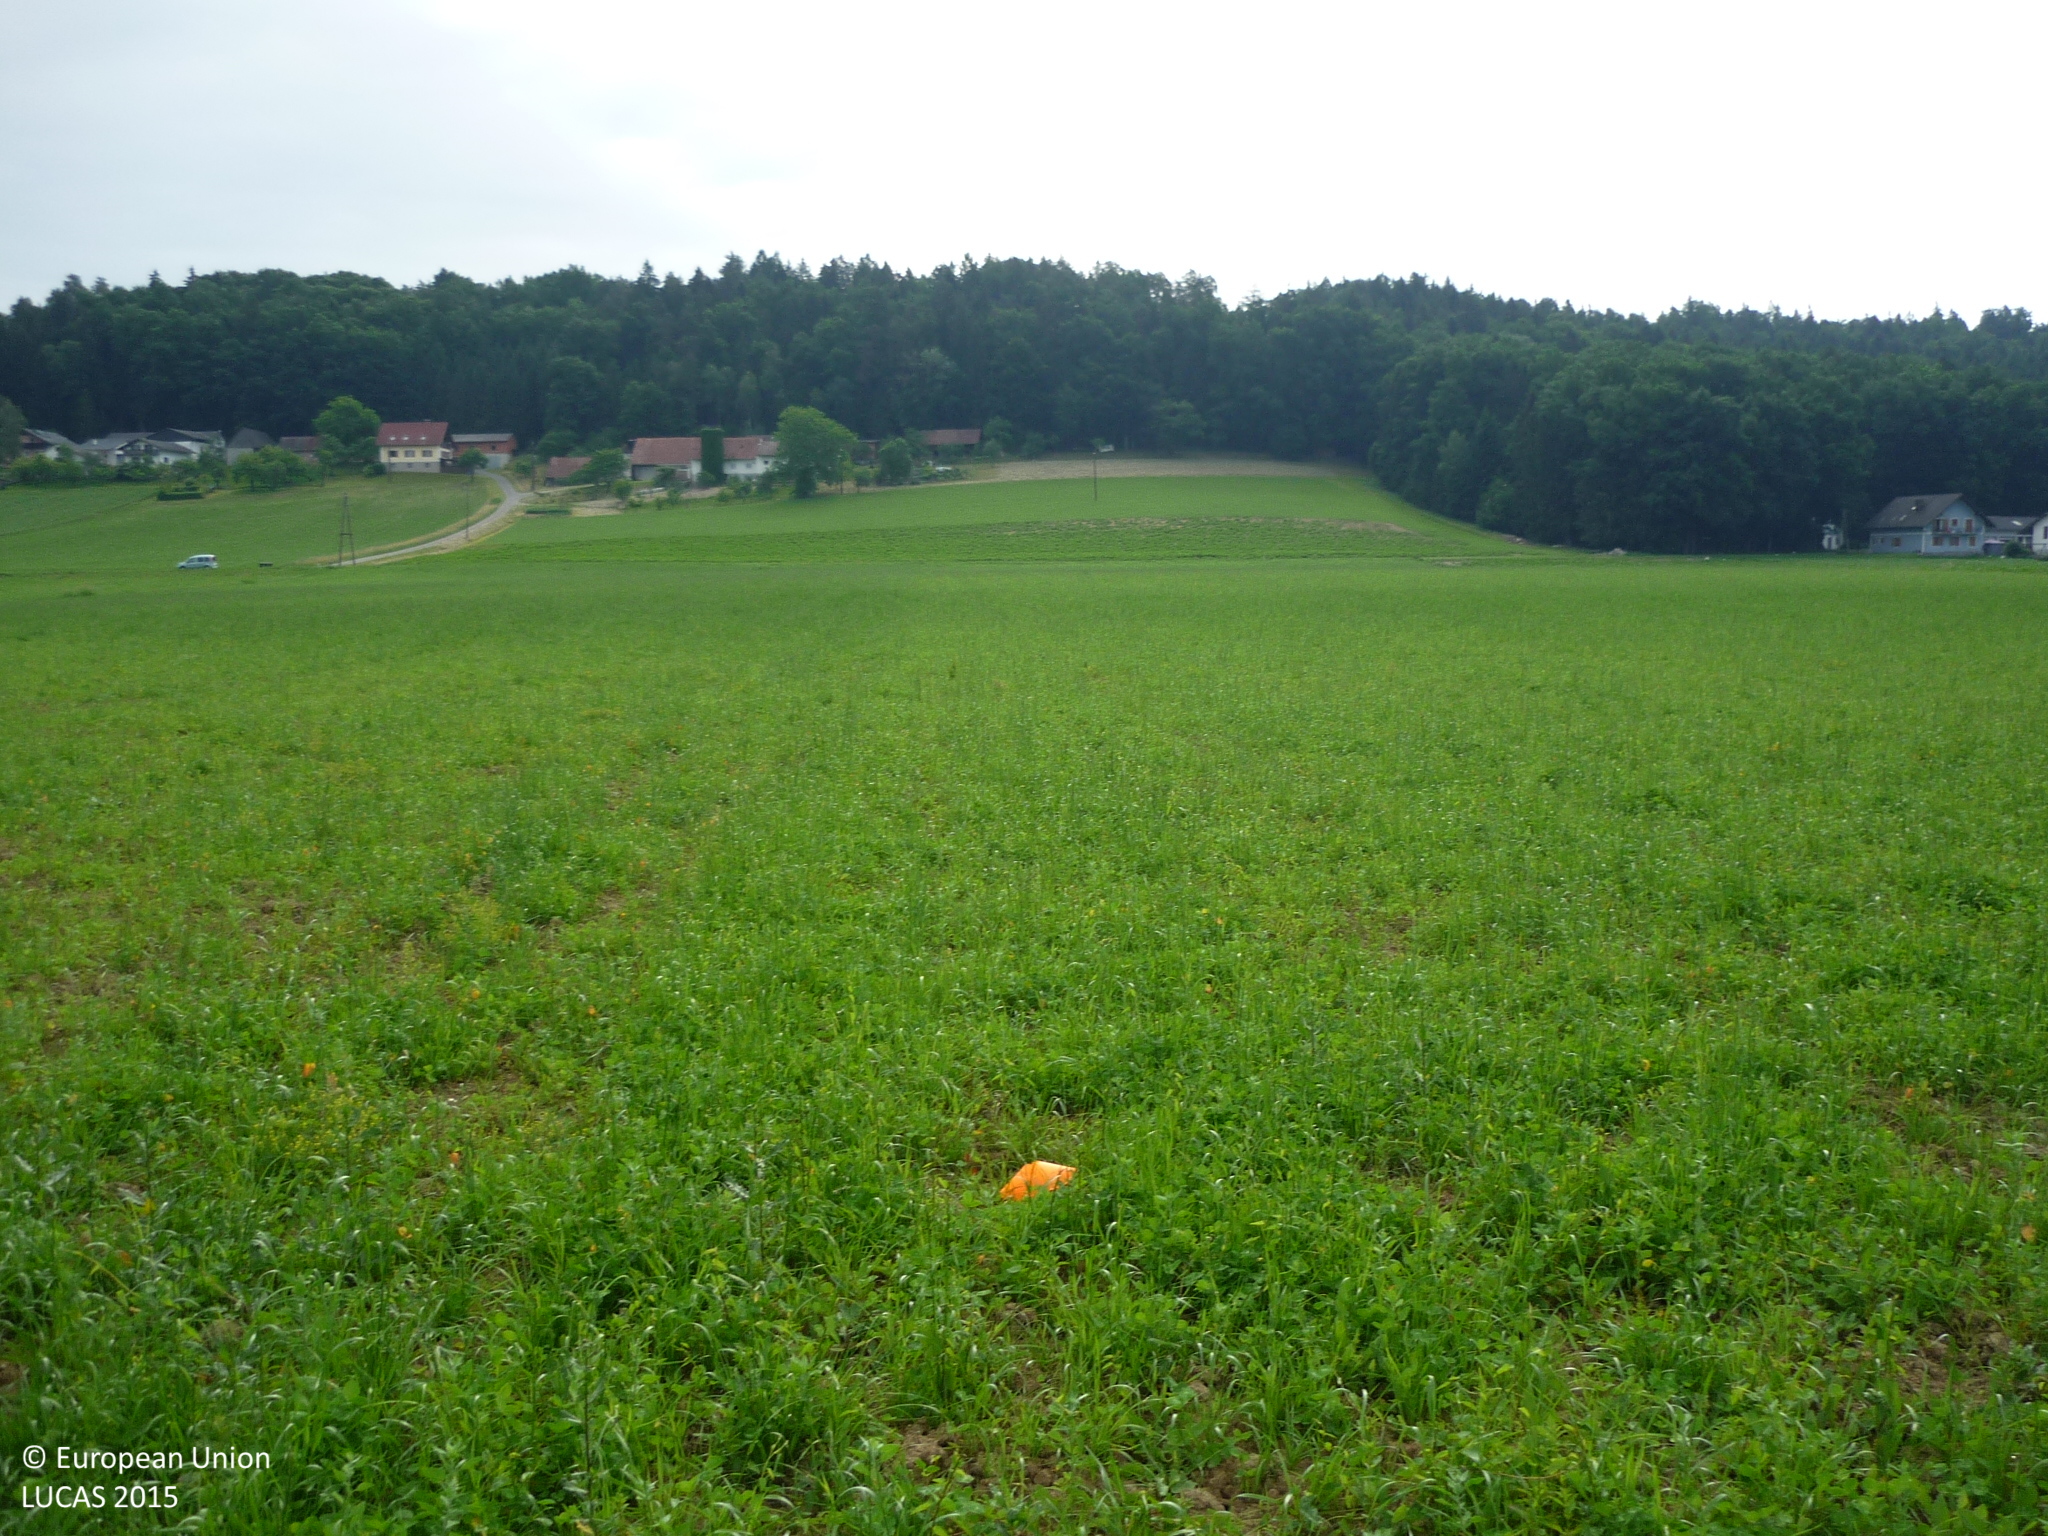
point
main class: Cropland
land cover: Temporary grasslands
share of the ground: > 75 %
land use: Agriculture (excluding fallow land and kitchen gardens)
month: June
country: AT
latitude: 46.7978
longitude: 15.6466
